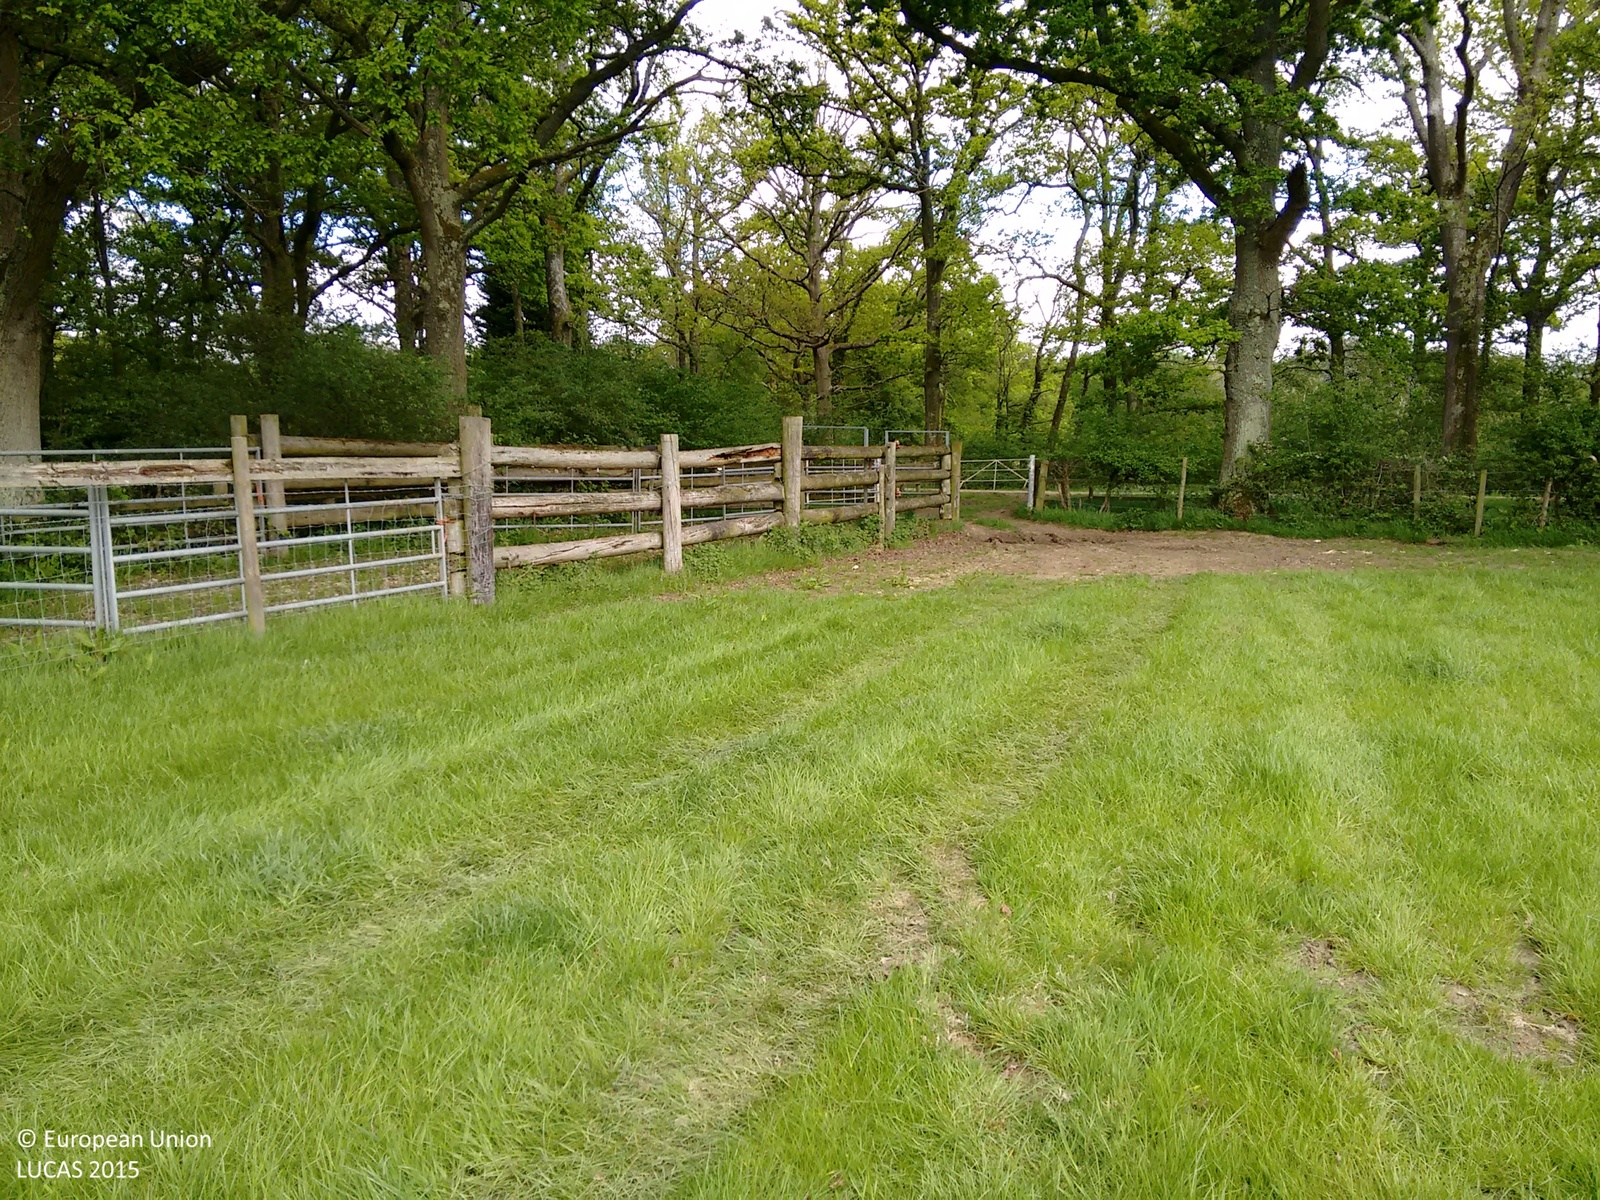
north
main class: Grassland
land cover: Grassland without tree/shrub cover
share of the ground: > 75 %
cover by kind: herbaceous plants 100 %
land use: Agriculture (excluding fallow land and kitchen gardens)
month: May
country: GB
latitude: 51.3249
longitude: -1.1392
